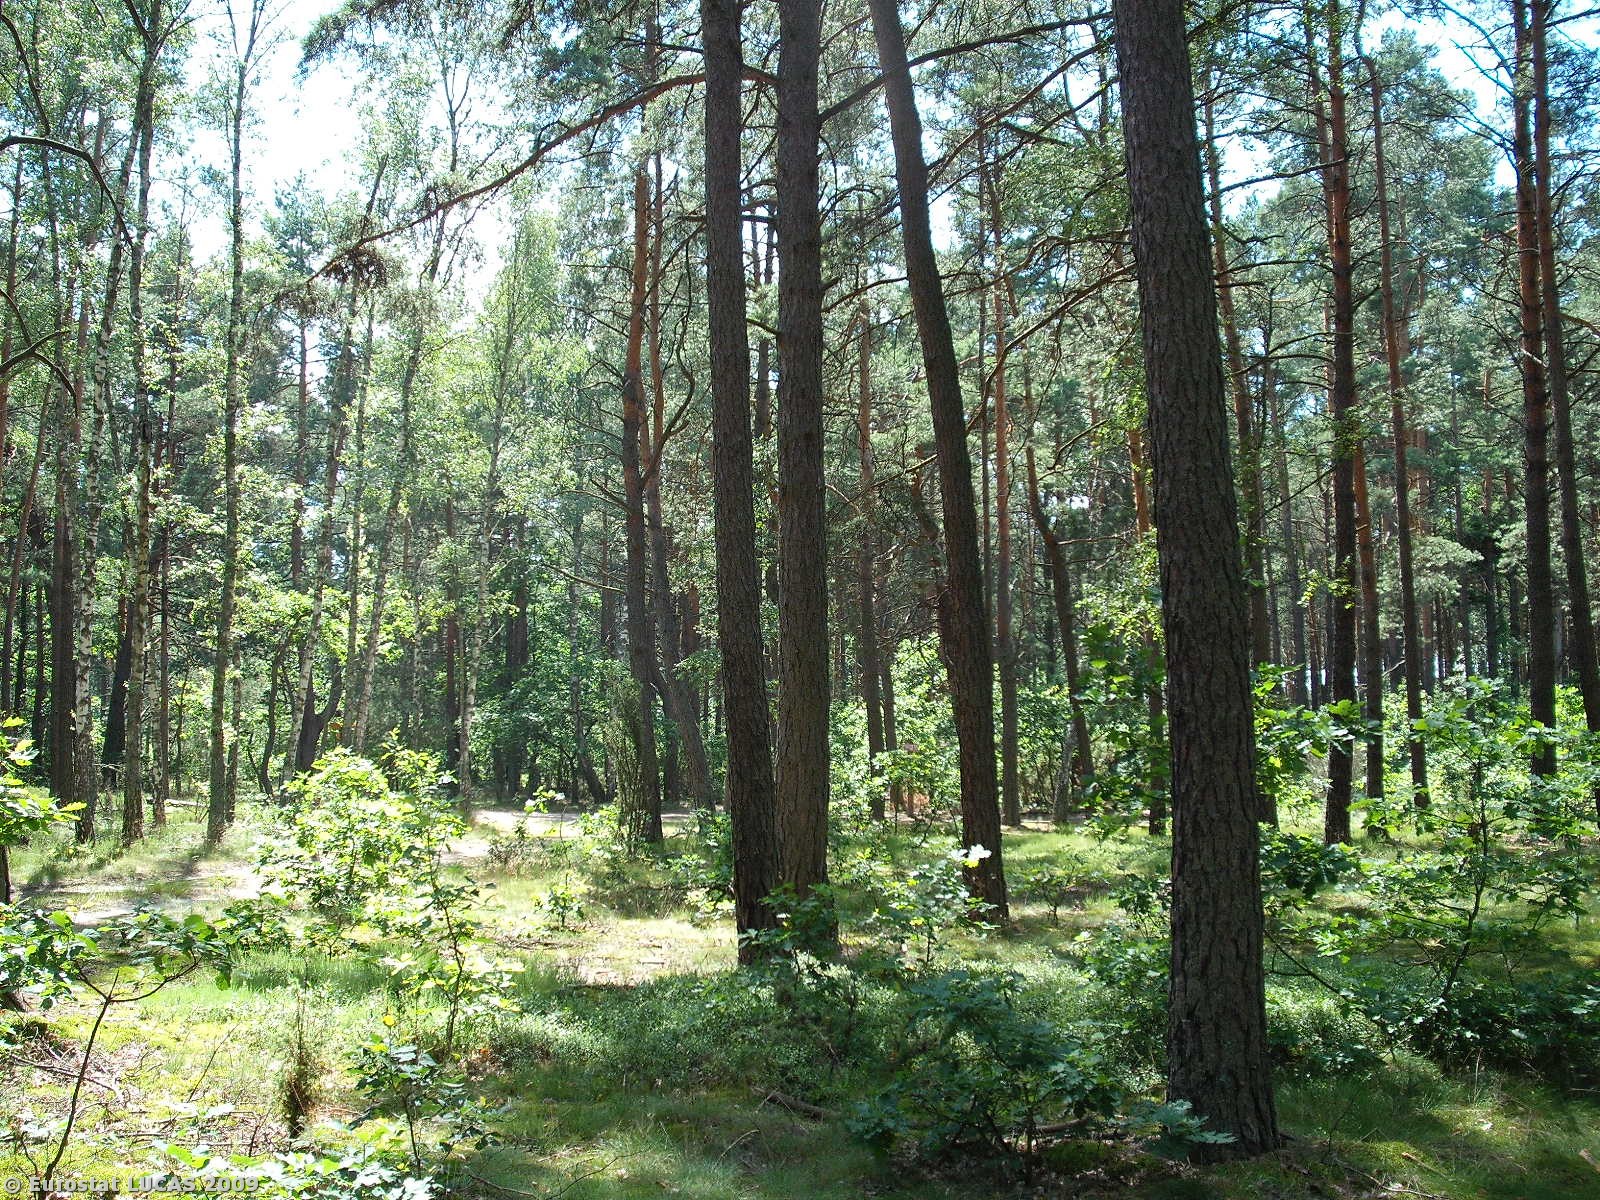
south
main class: Woodland
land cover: Coniferous woodland
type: hemiboreal forest and nemoral coniferous forest and mixed broadleaved-coniferous forest
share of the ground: > 75 %
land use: Forestry
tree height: > 5 m
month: July
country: PL
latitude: 52.3244
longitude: 20.7371
